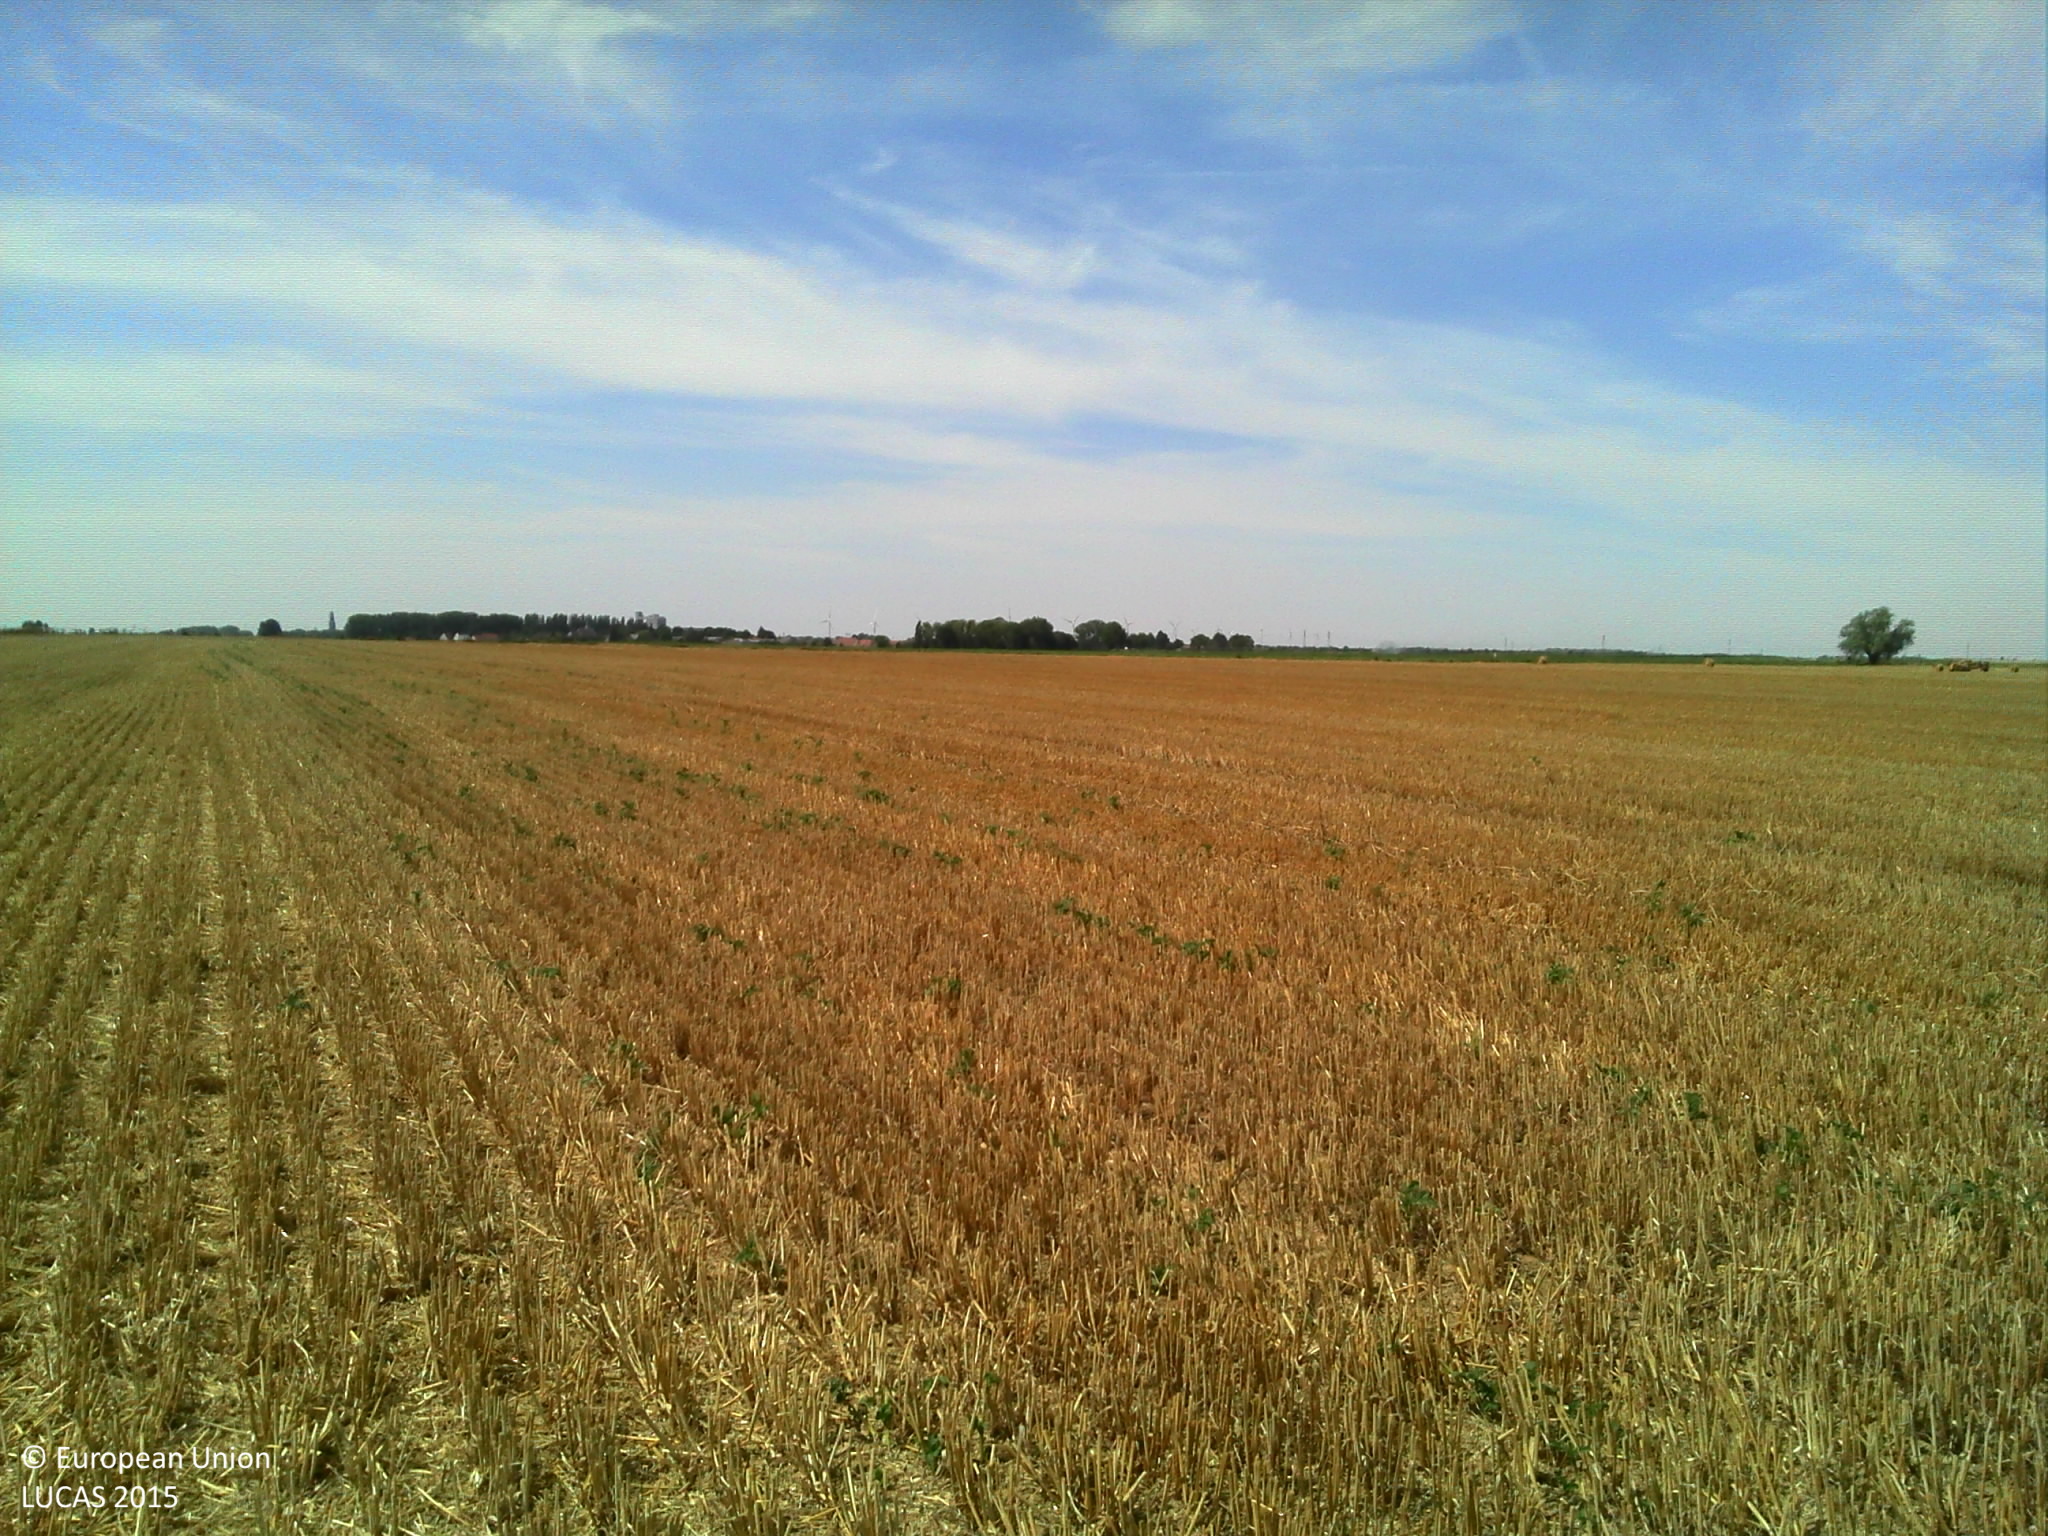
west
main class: Cropland
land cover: Common wheat
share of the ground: > 75 %
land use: Agriculture (excluding fallow land and kitchen gardens)
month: August
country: FR
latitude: 49.7068
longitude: 2.8483
